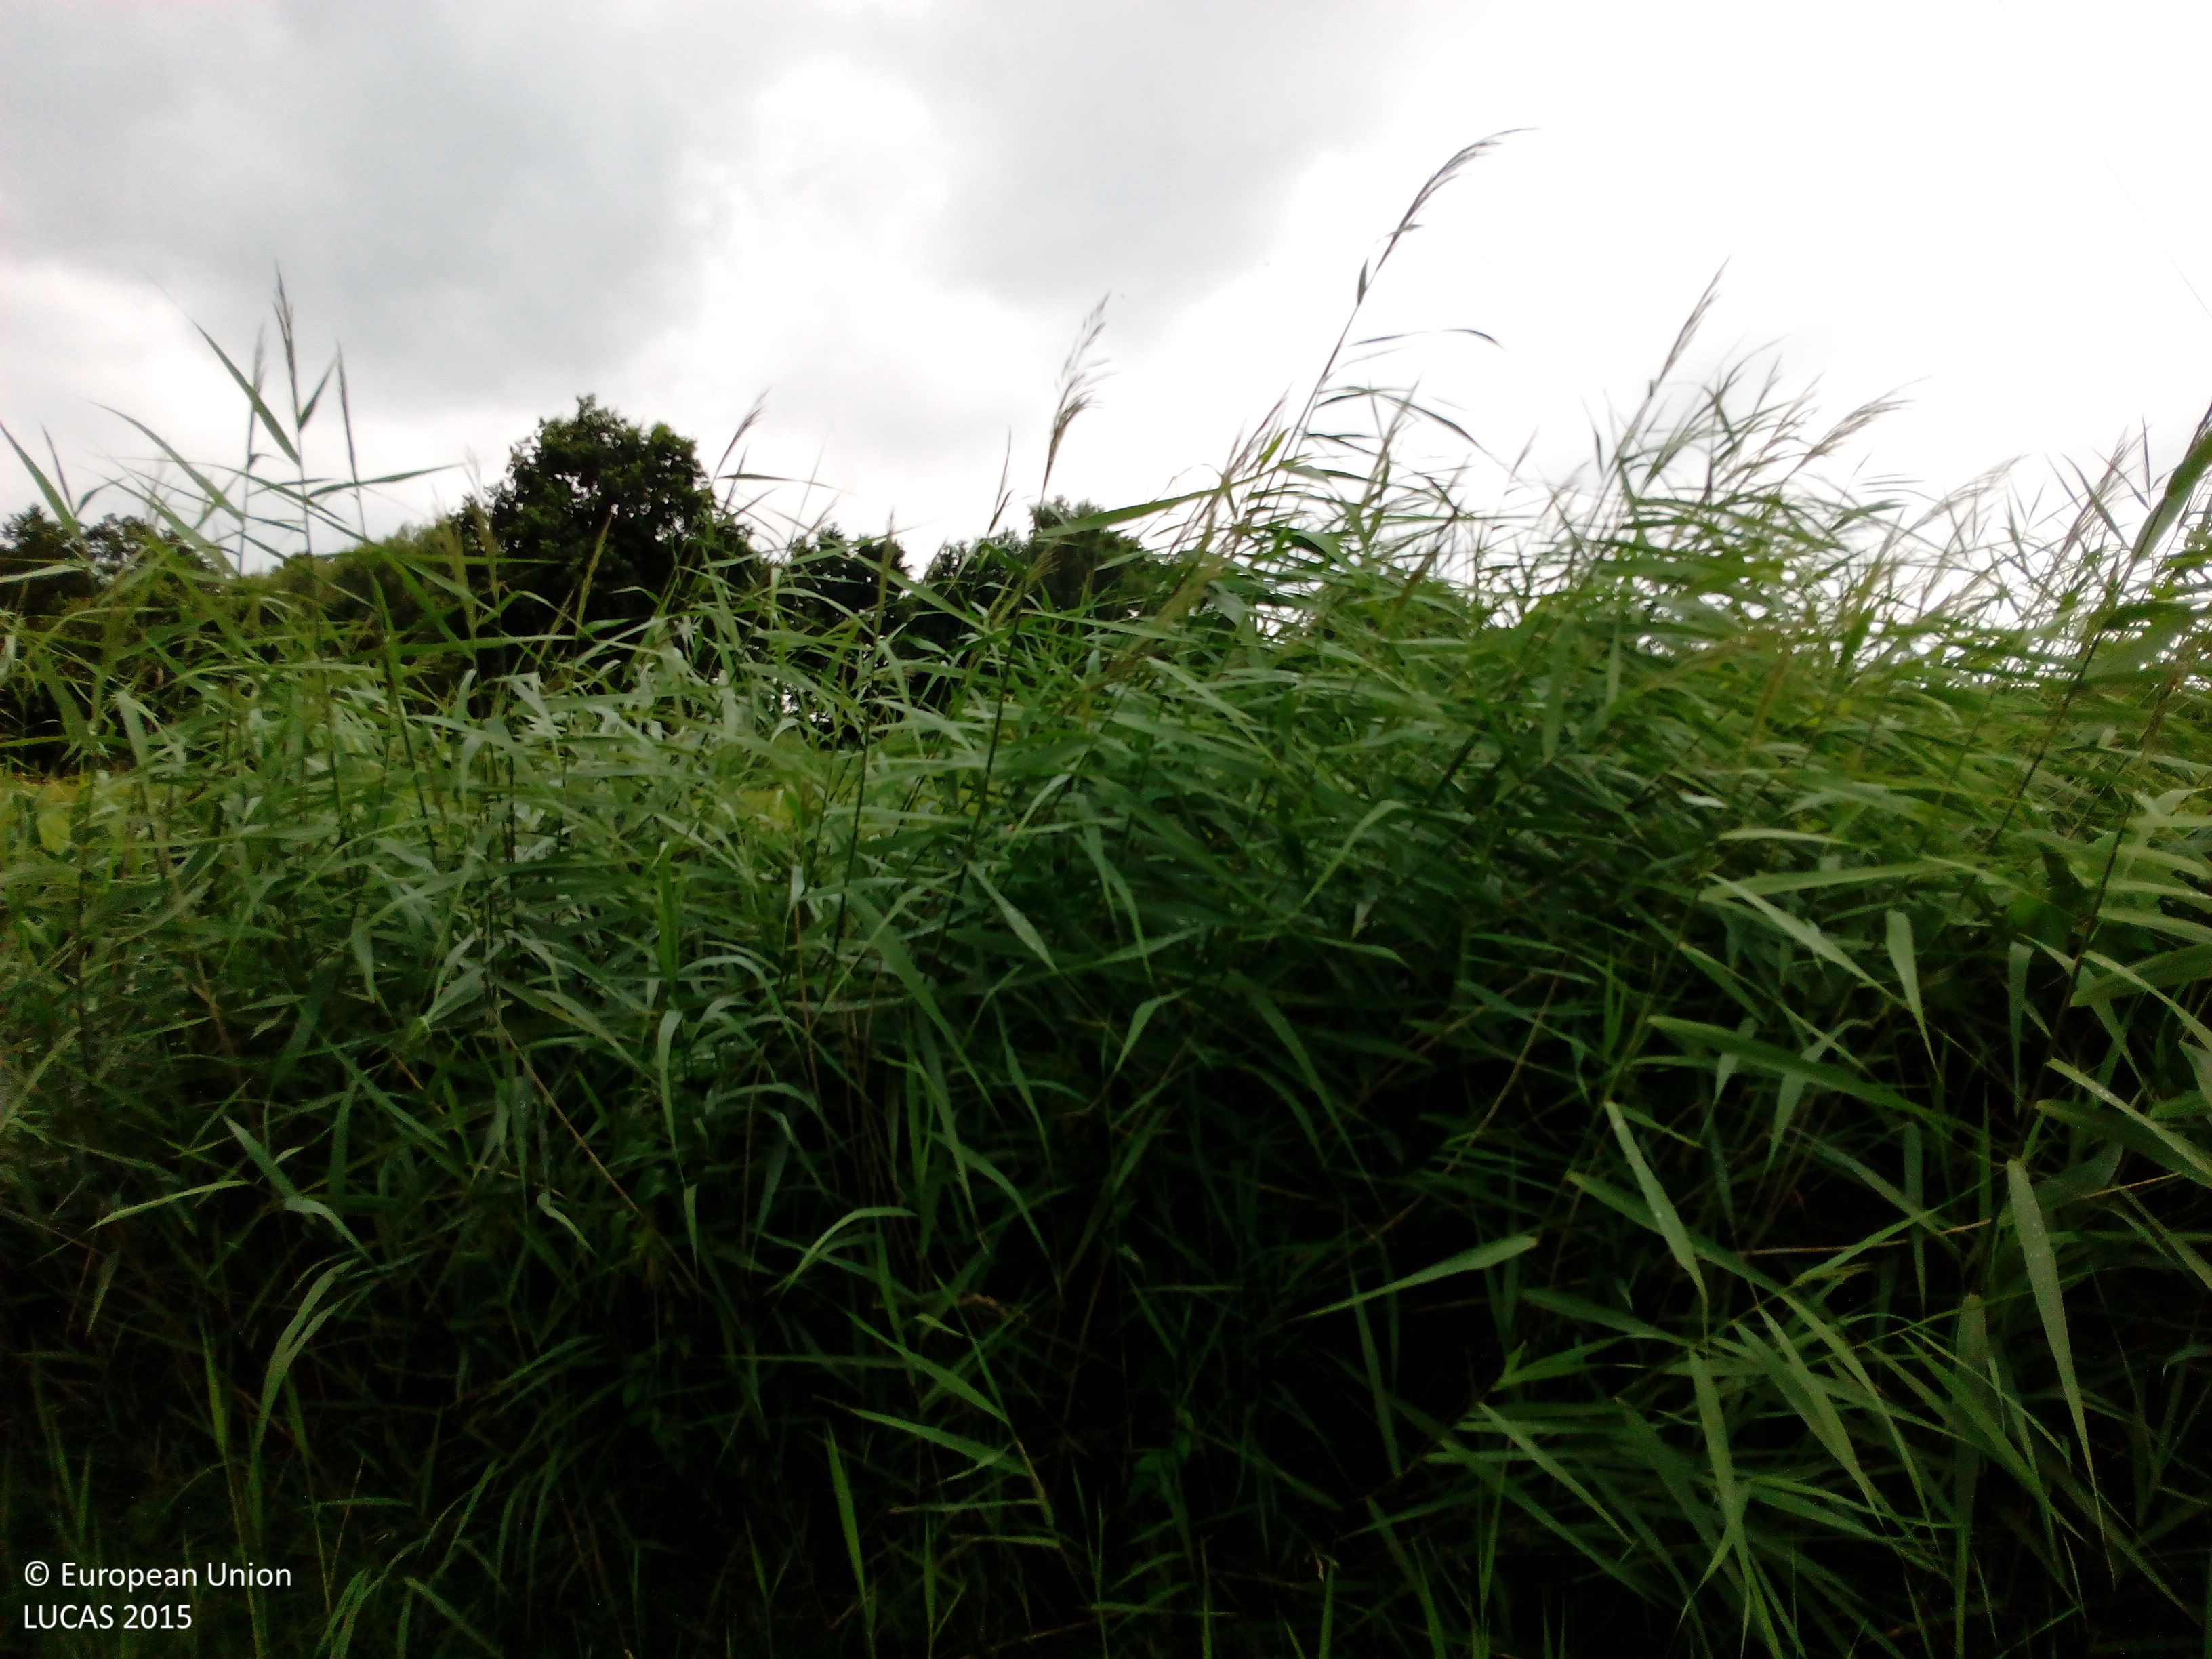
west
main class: Grassland
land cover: Grassland without tree/shrub cover
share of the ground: > 75 %
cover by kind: herbaceous plants 100 %
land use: Agriculture (excluding fallow land and kitchen gardens)
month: July
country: DE
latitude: 52.3240
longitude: 7.9610
